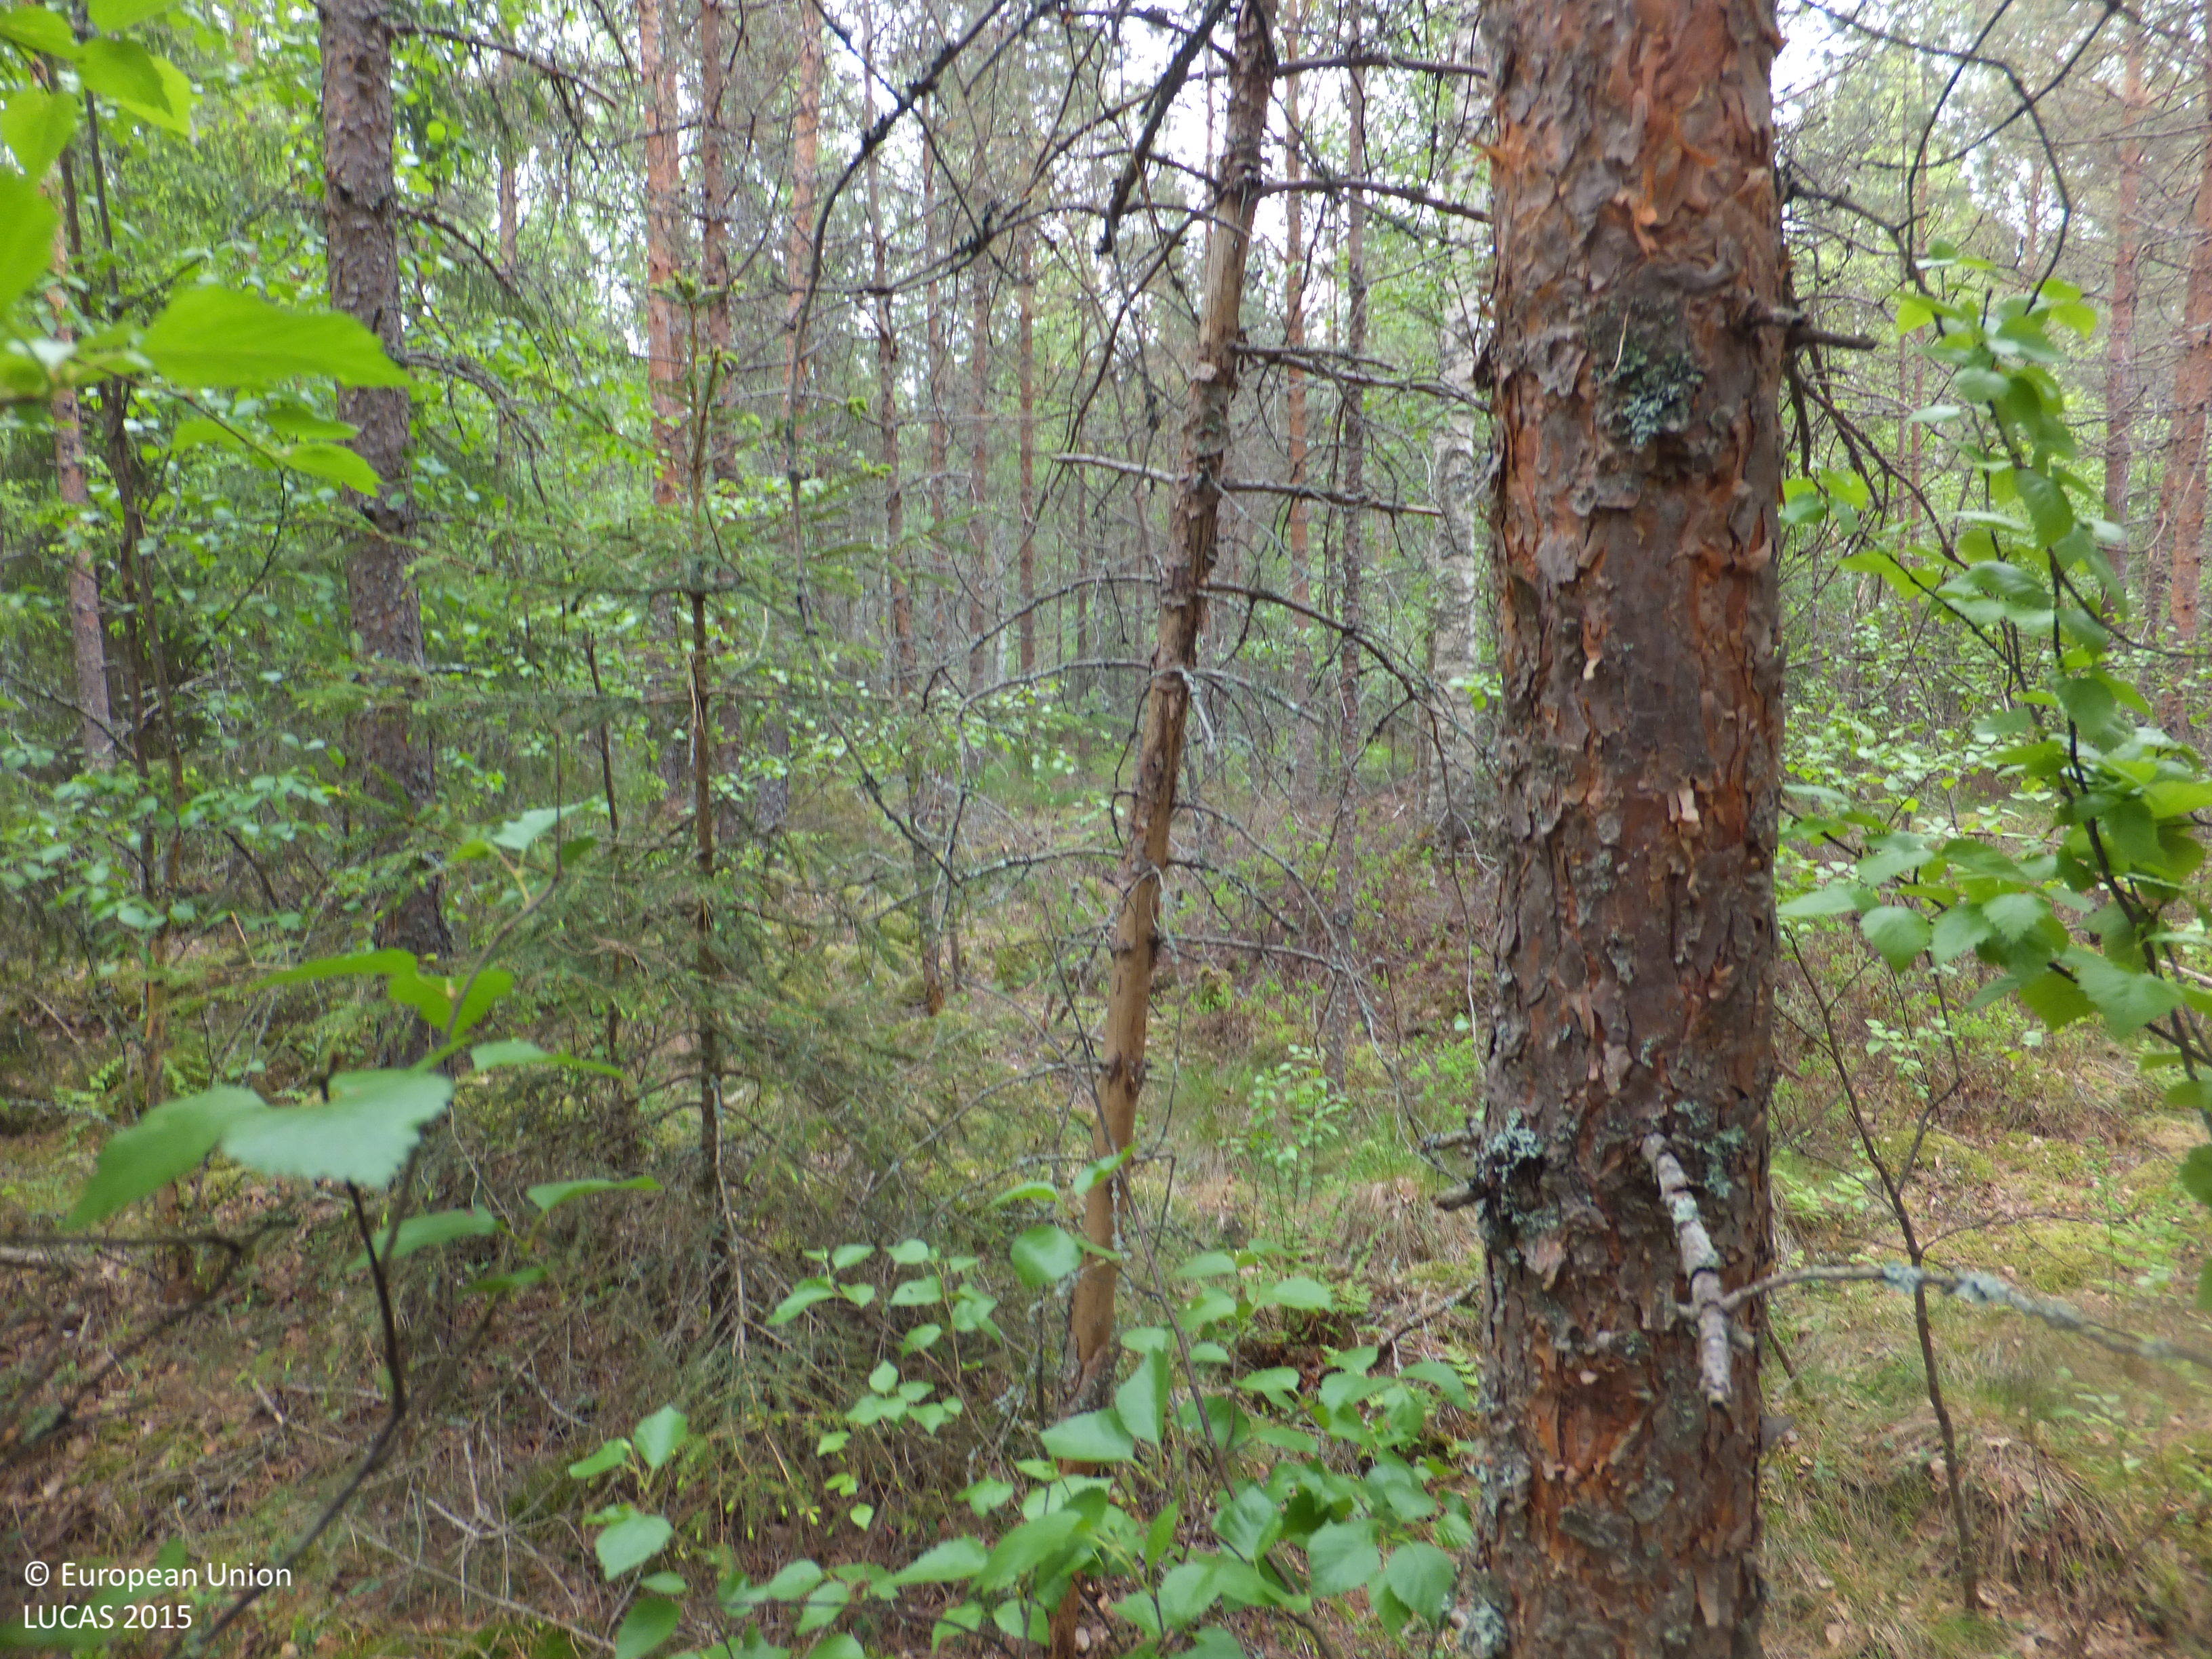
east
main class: Woodland
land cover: Pine dominated mixed woodland
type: boreal forest
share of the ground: > 75 %
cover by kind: coniferous forest trees 70 %, broadleaved forest trees 25 %, shrubs 5 %
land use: Forestry
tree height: > 5 m
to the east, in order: Pine dominated mixed woodland; Ditches and canals; Pine dominated mixed woodland; Ditches and canals; Pine dominated mixed woodland; Ditches and canals; Pine dominated mixed woodland; Paved roads, cycling and walking lanes; Pine dominated mixed woodland; Pine dominated coniferous woodland; Broadleaved woodland
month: June
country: FI
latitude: 63.3184
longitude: 22.6869
